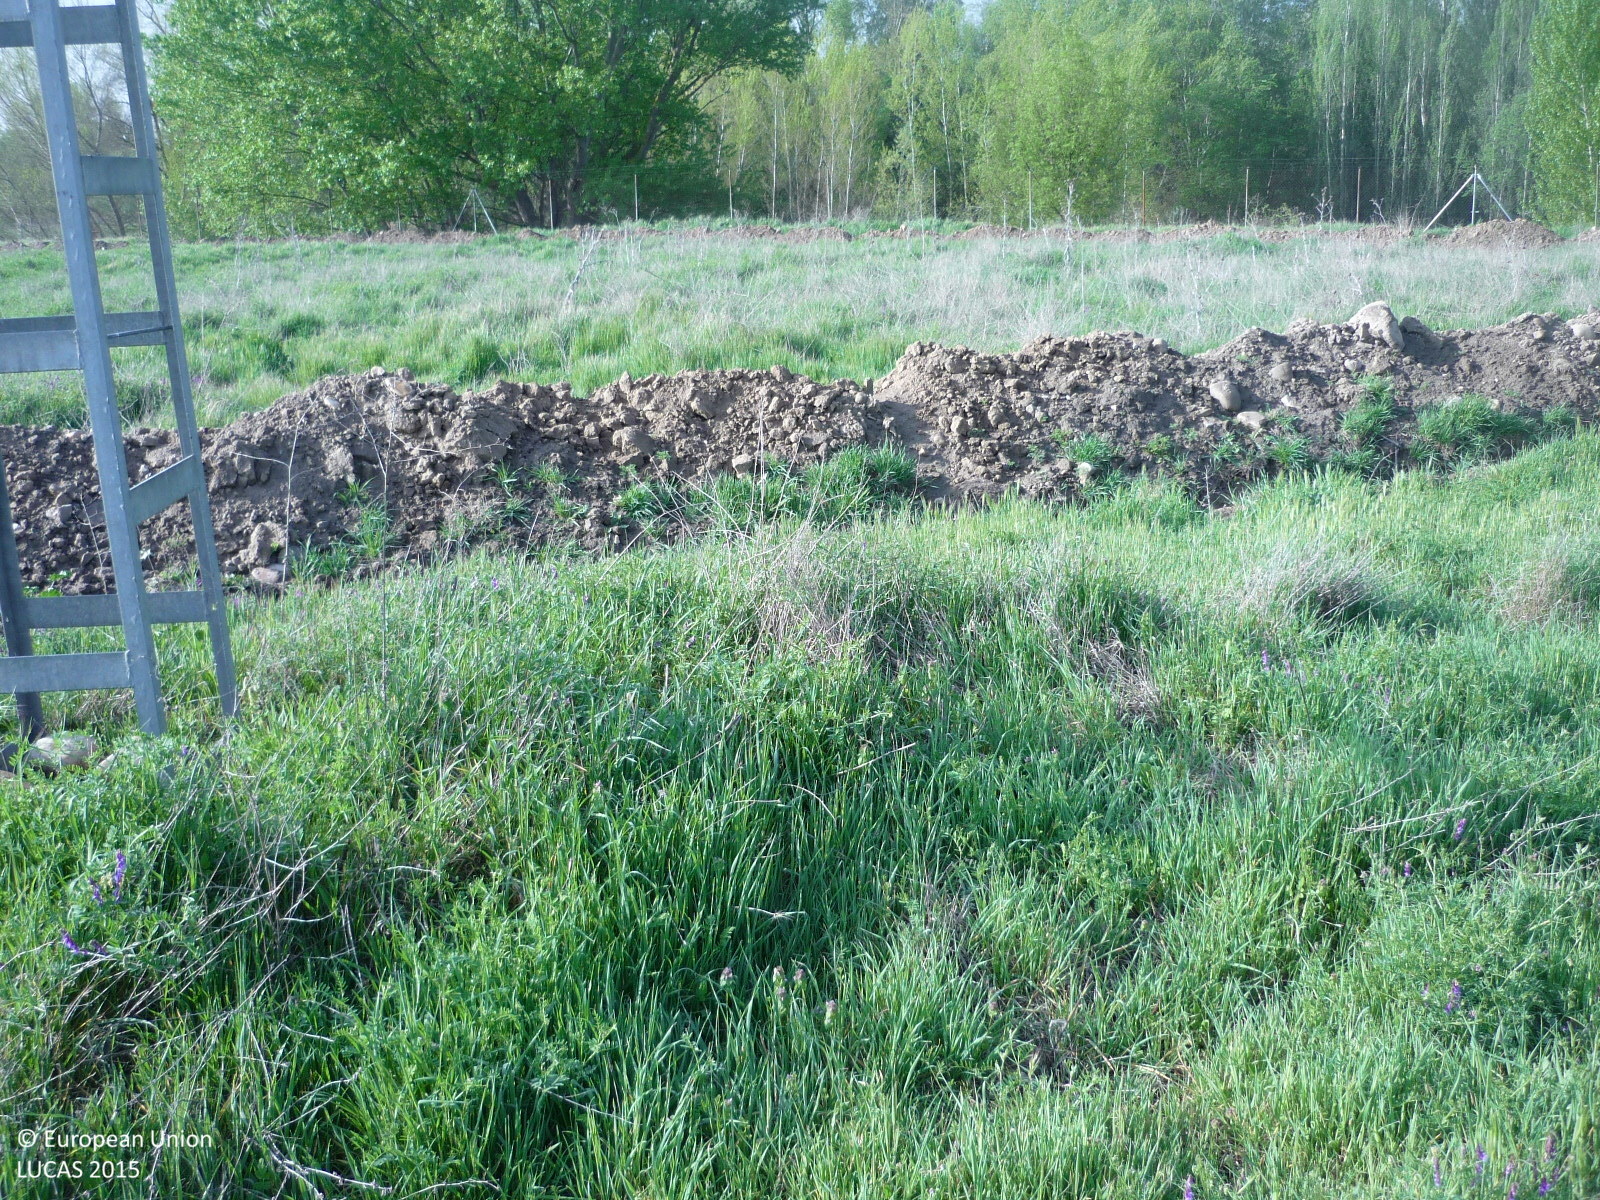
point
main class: Grassland
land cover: Grassland without tree/shrub cover
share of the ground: > 75 %
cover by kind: herbaceous plants 90 %, unconsolidated bare surface 10 %
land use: Semi-natural and natural areas not in use
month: April
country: ES
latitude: 40.5484
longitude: -3.5578
